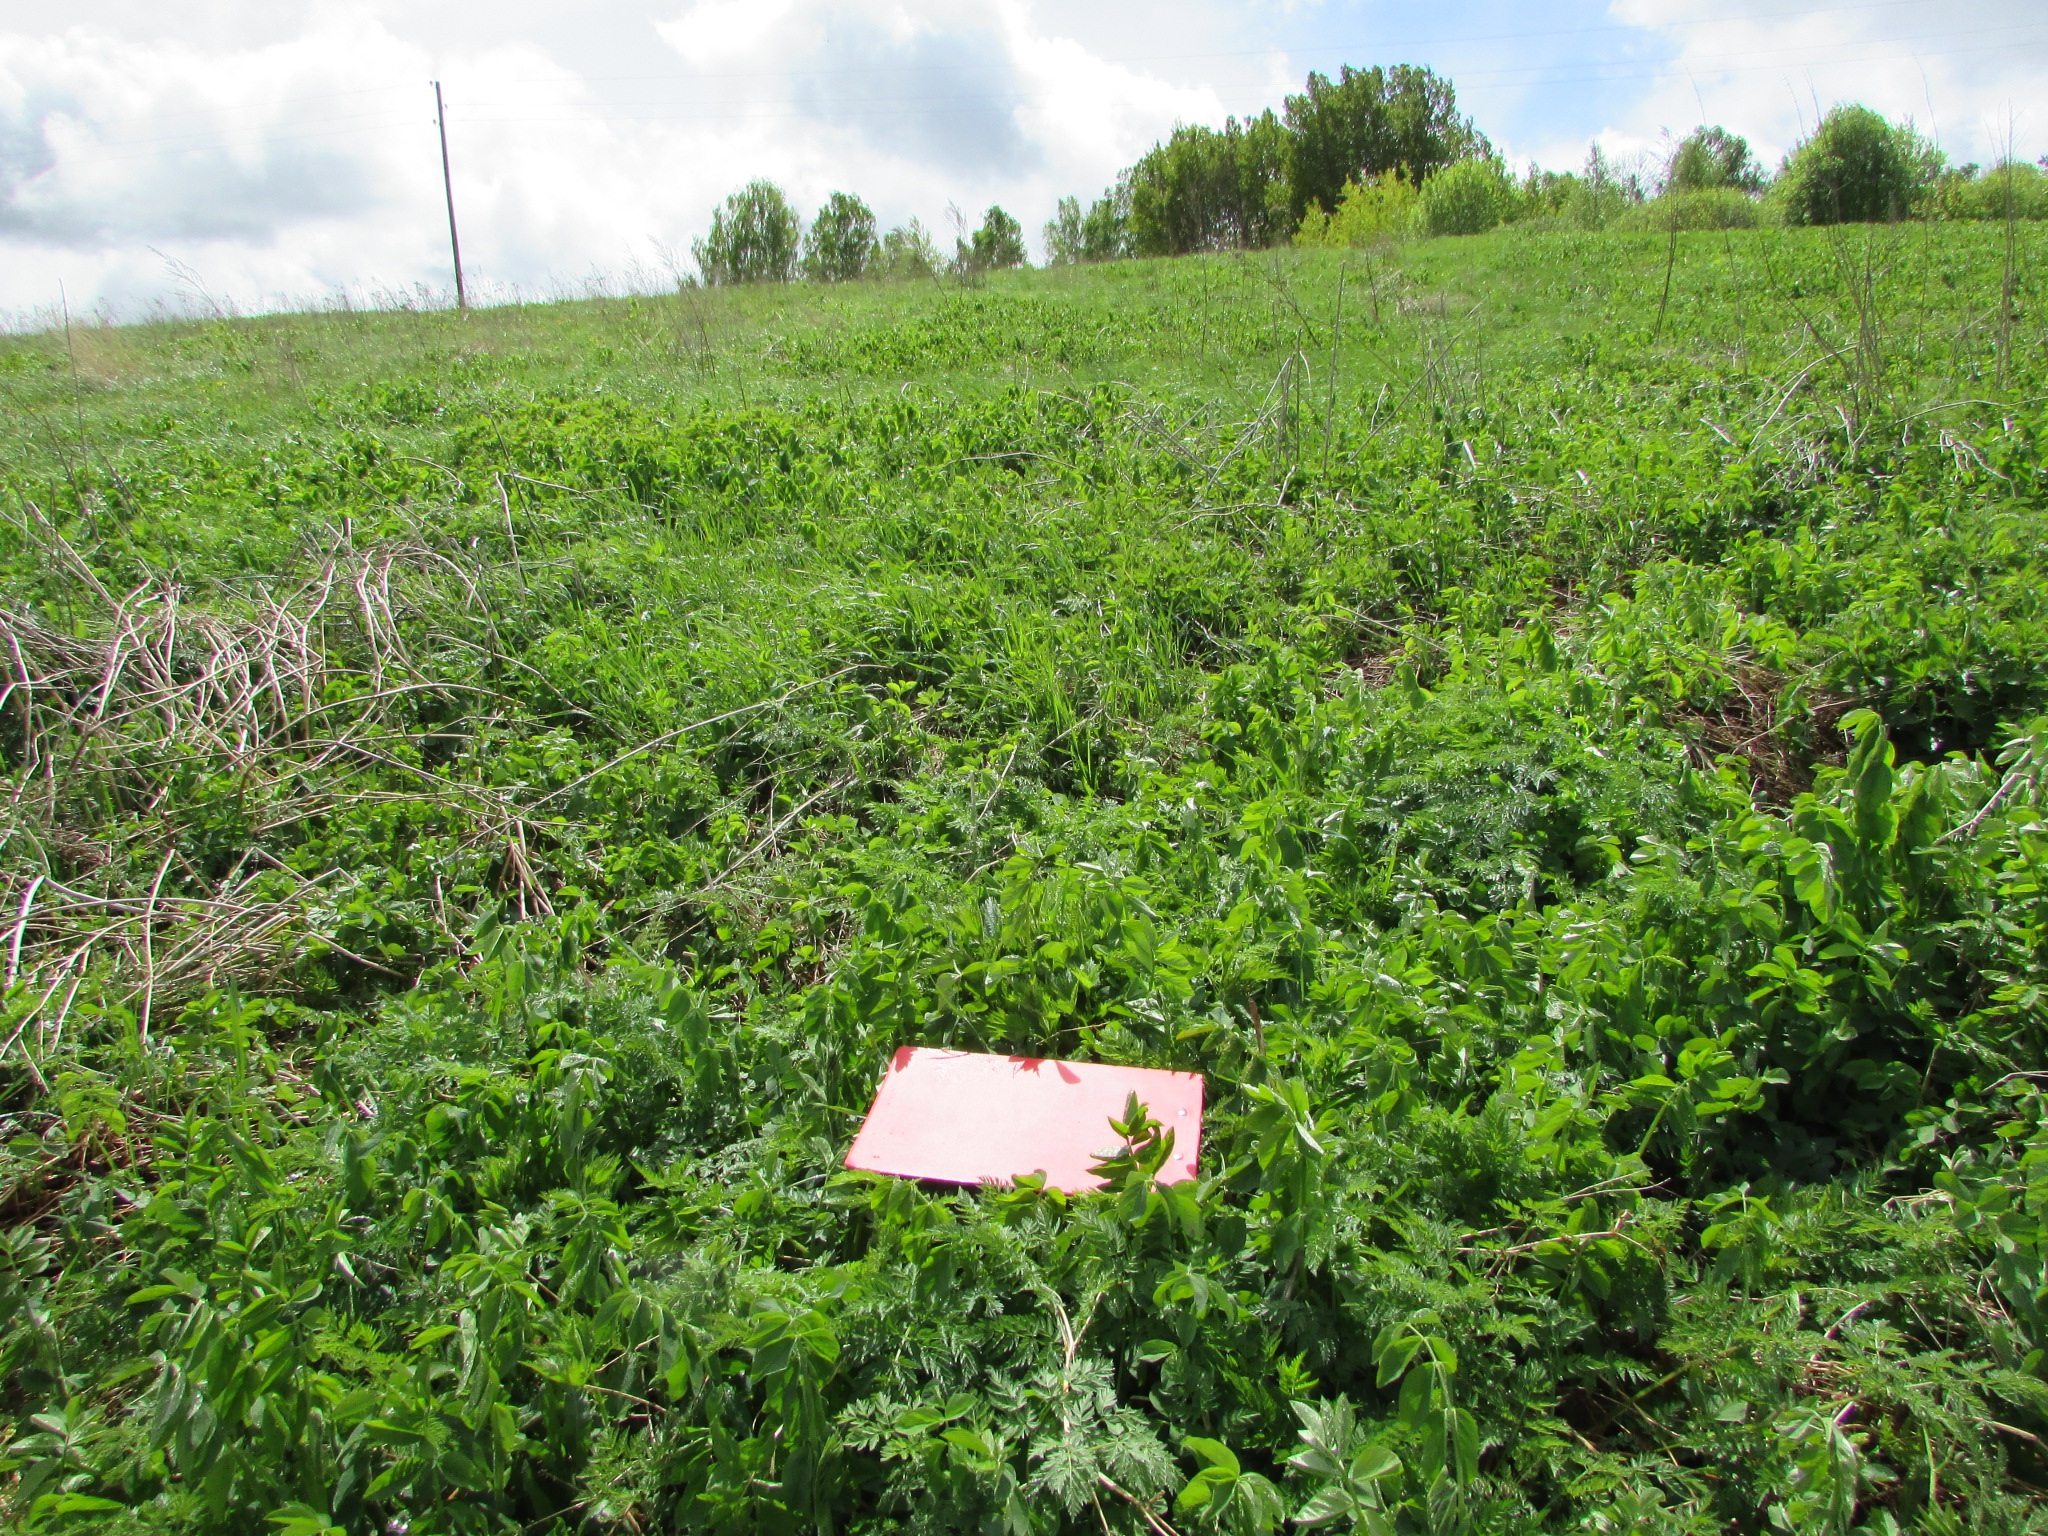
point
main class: Grassland
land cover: Grassland without tree/shrub cover
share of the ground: > 75 %
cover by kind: herbaceous plants 100 %
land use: Agriculture (excluding fallow land and kitchen gardens)
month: May
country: LV
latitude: 56.1318
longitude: 27.3767
